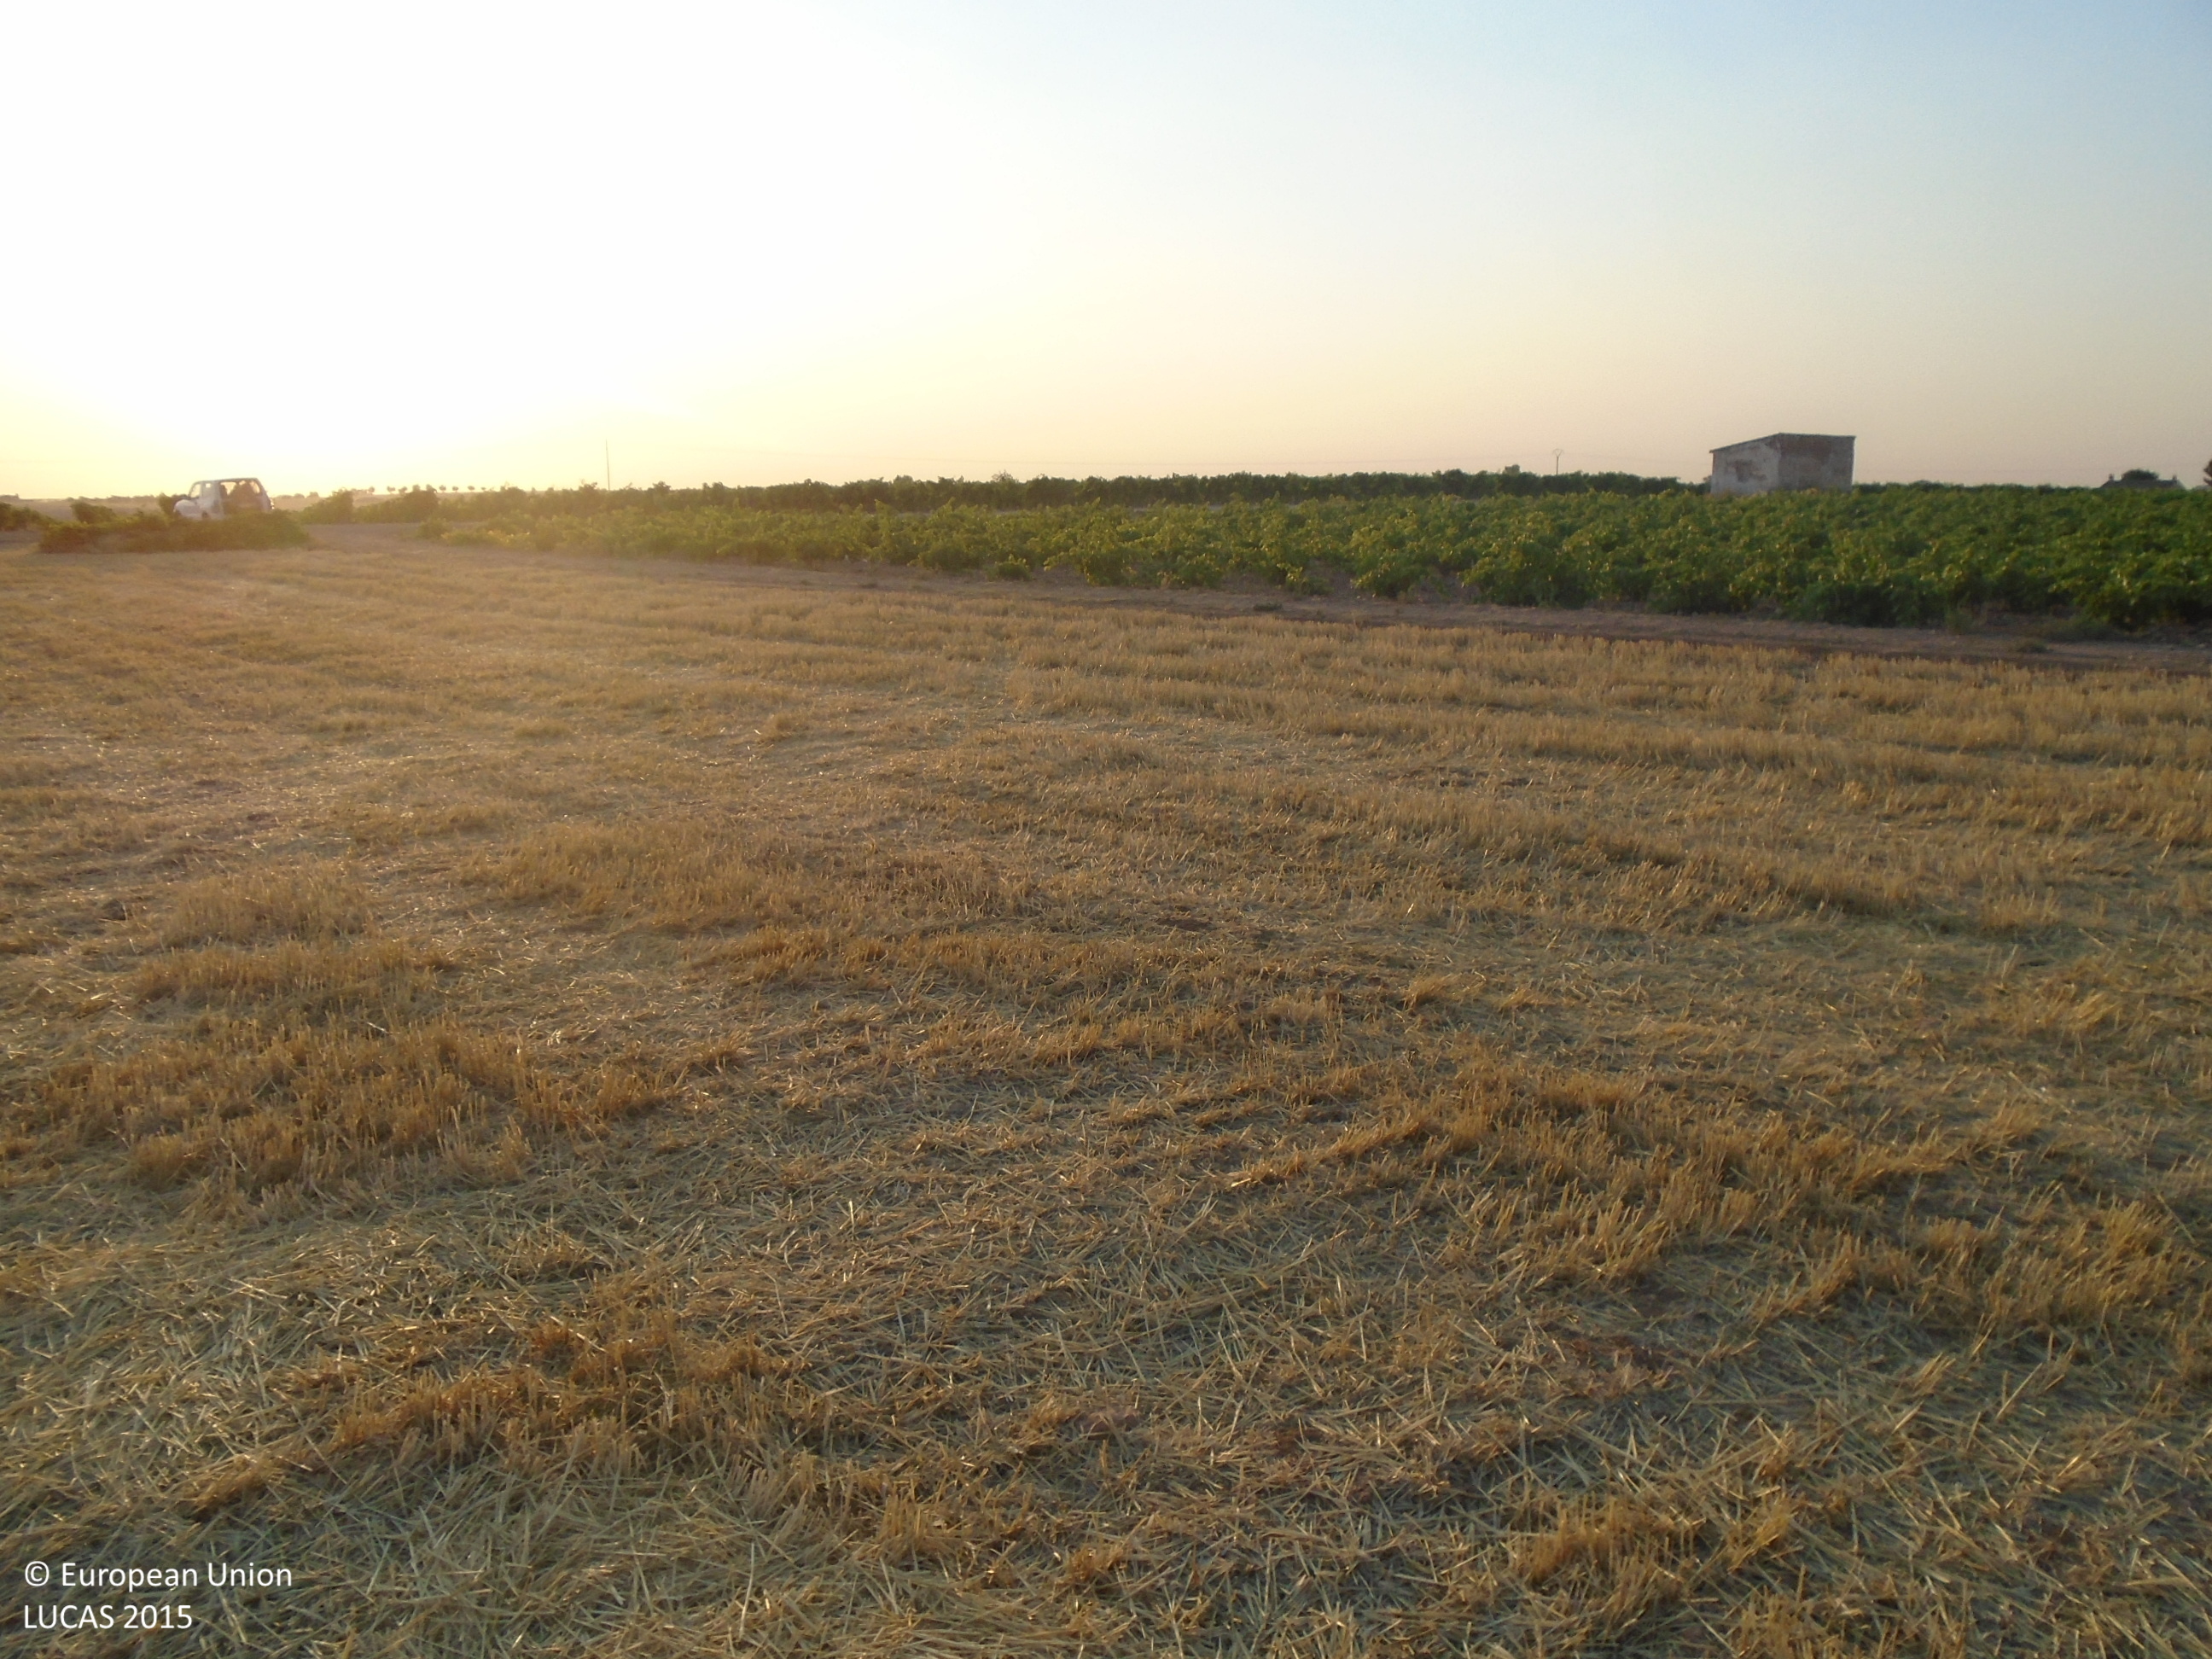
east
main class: Cropland
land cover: Barley
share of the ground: > 75 %
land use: Agriculture (excluding fallow land and kitchen gardens)
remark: Harvested field
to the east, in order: Barley; Tracks; Vineyards; Grass margins; Tracks; Grass margins; Vineyards
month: June
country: ES
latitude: 39.1096
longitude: -3.6302
